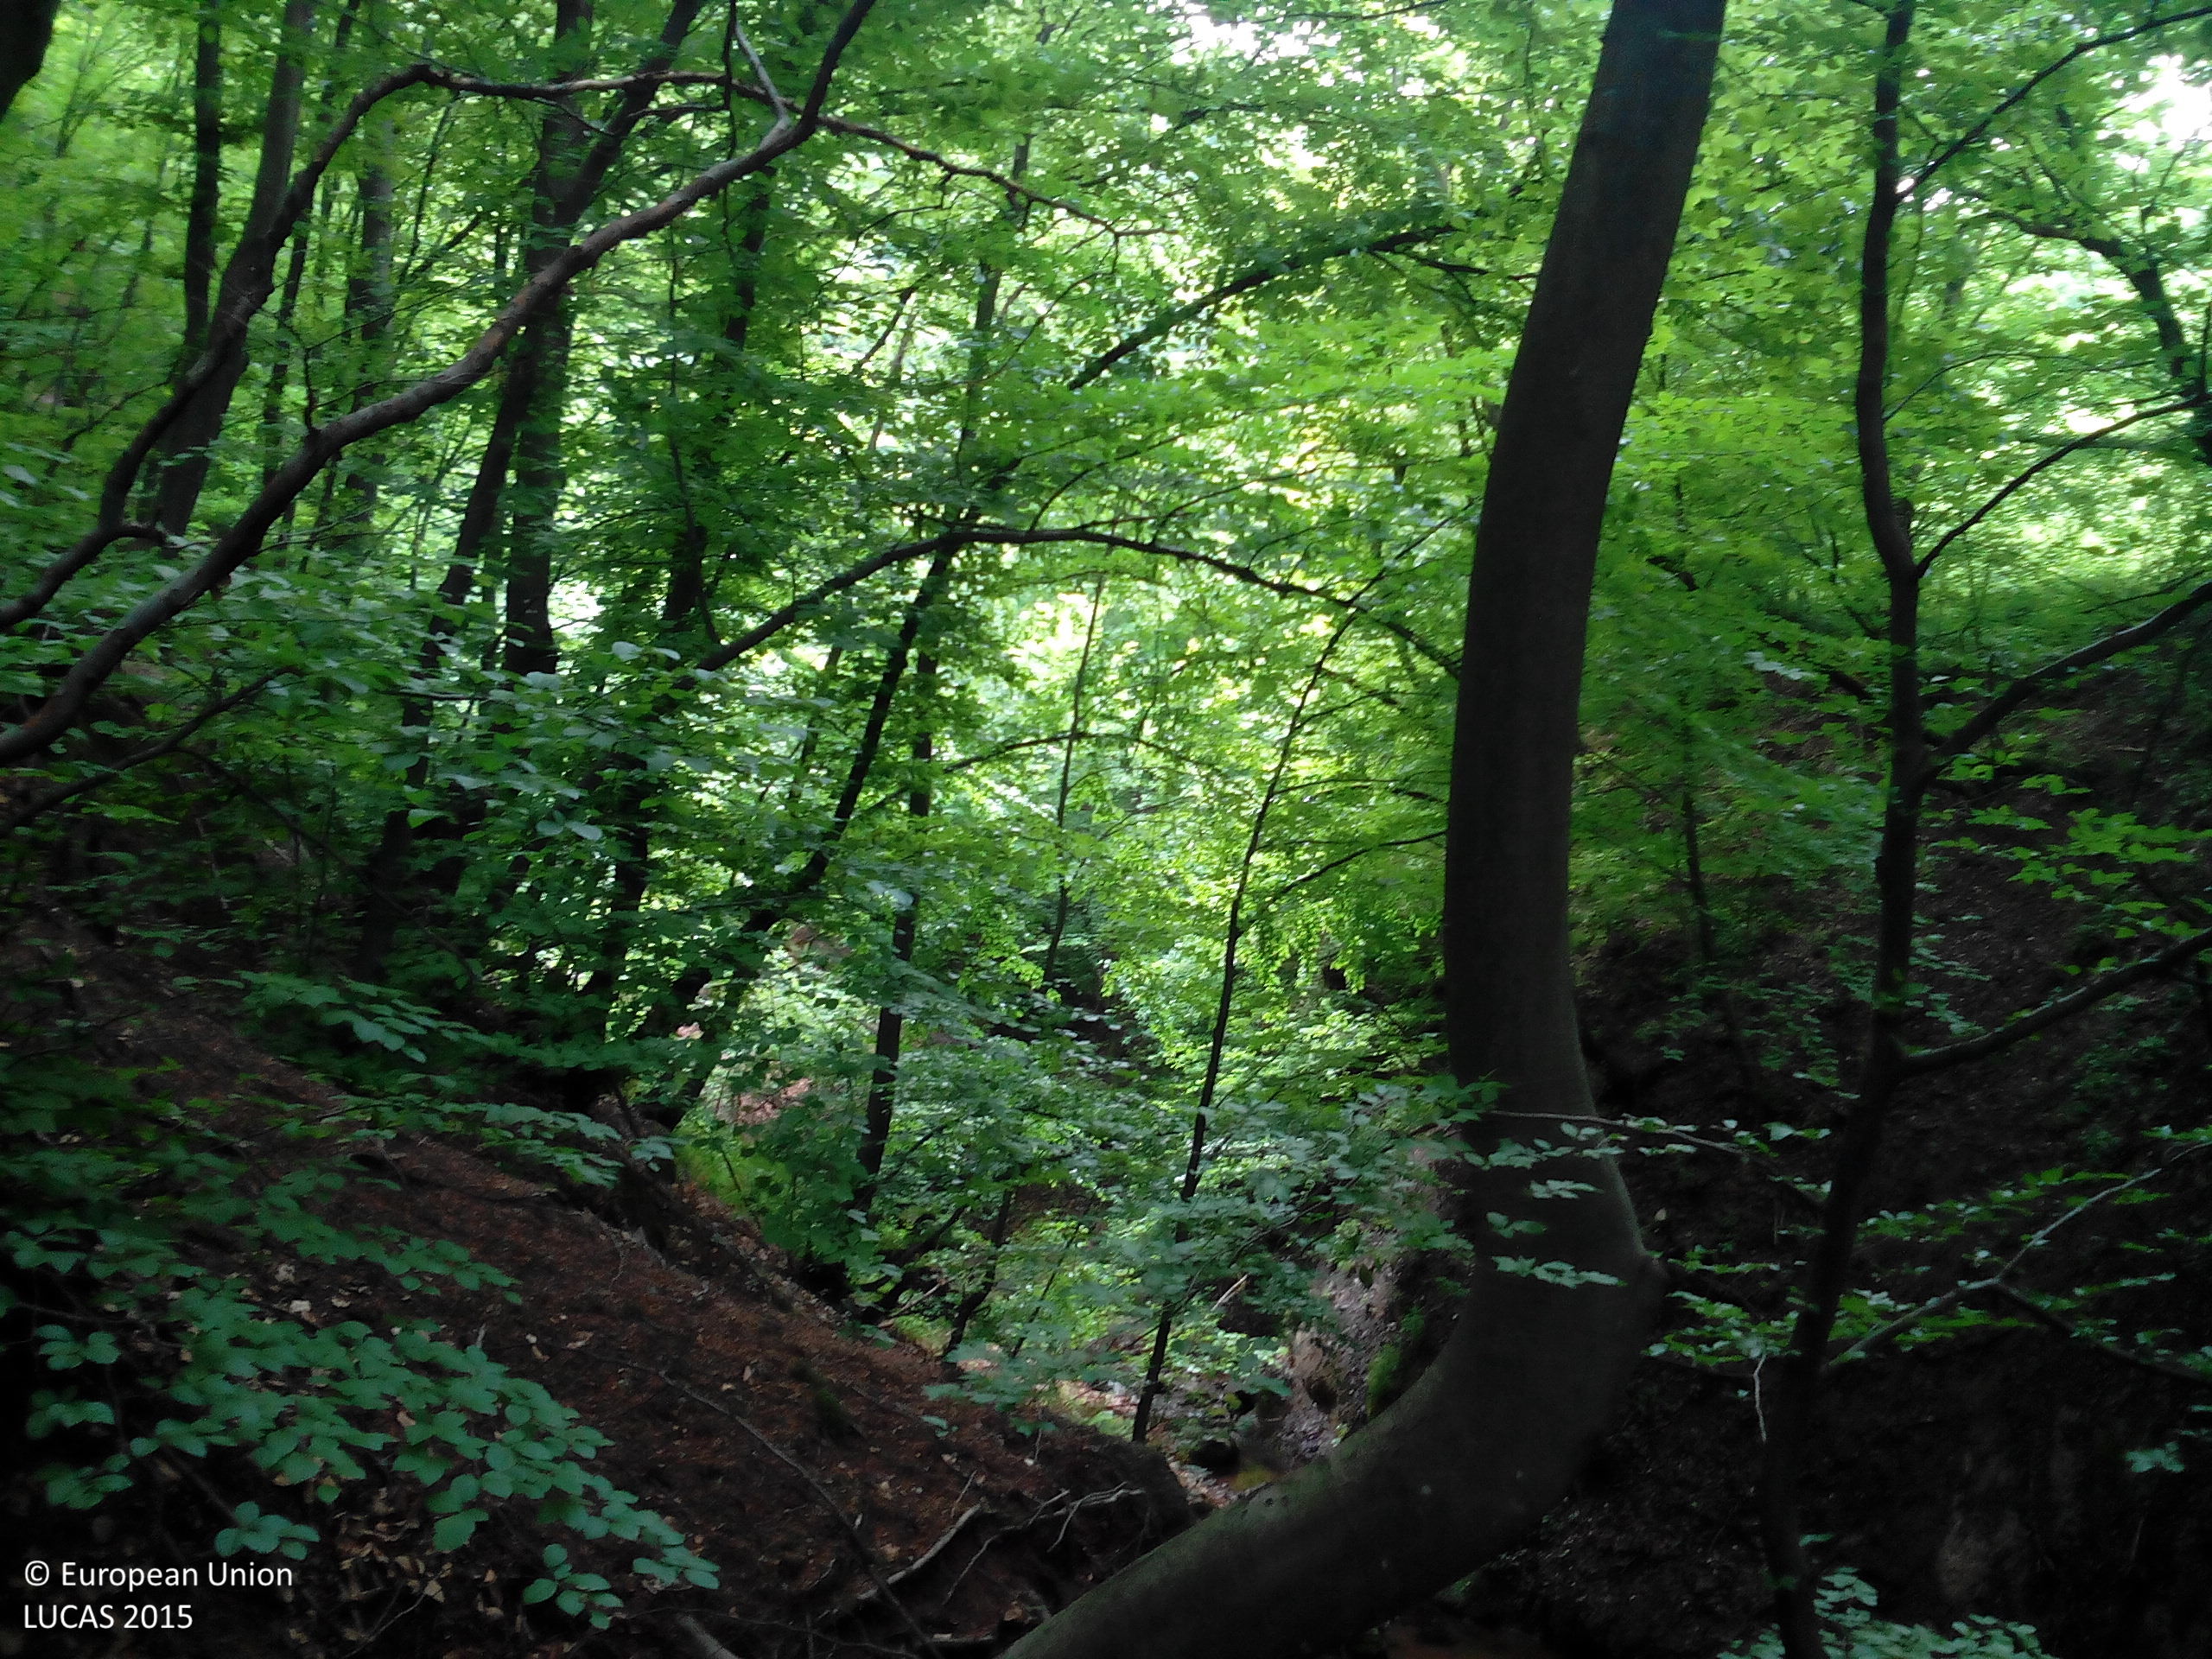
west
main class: Woodland
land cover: Broadleaved woodland
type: beech forest
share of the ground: > 75 %
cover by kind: broadleaved forest trees 100 %
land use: Forestry
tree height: > 5 m
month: May
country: BG
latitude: 43.1877
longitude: 23.5151
